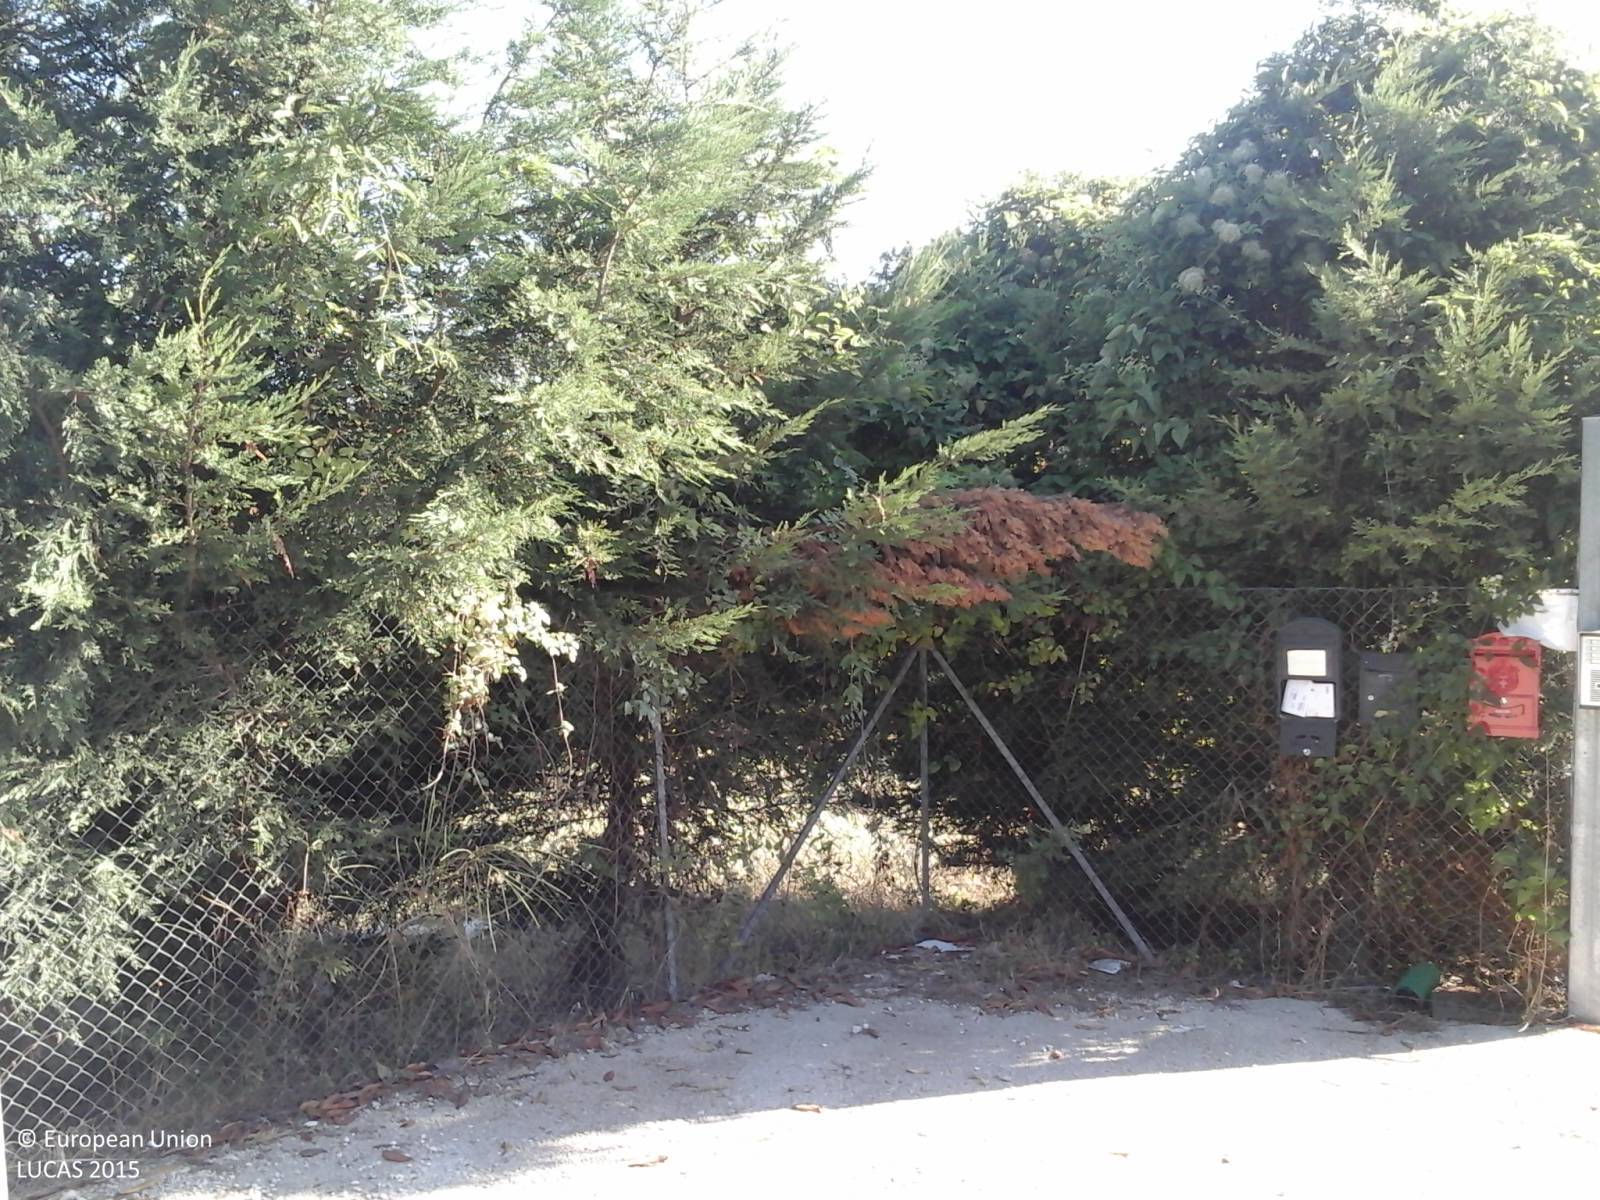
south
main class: Grassland
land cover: Grassland without tree/shrub cover
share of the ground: 50 - 75 %
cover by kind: herbaceous plants 100 %
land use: Residential
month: July
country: IT
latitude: 42.1202
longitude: 12.3743
